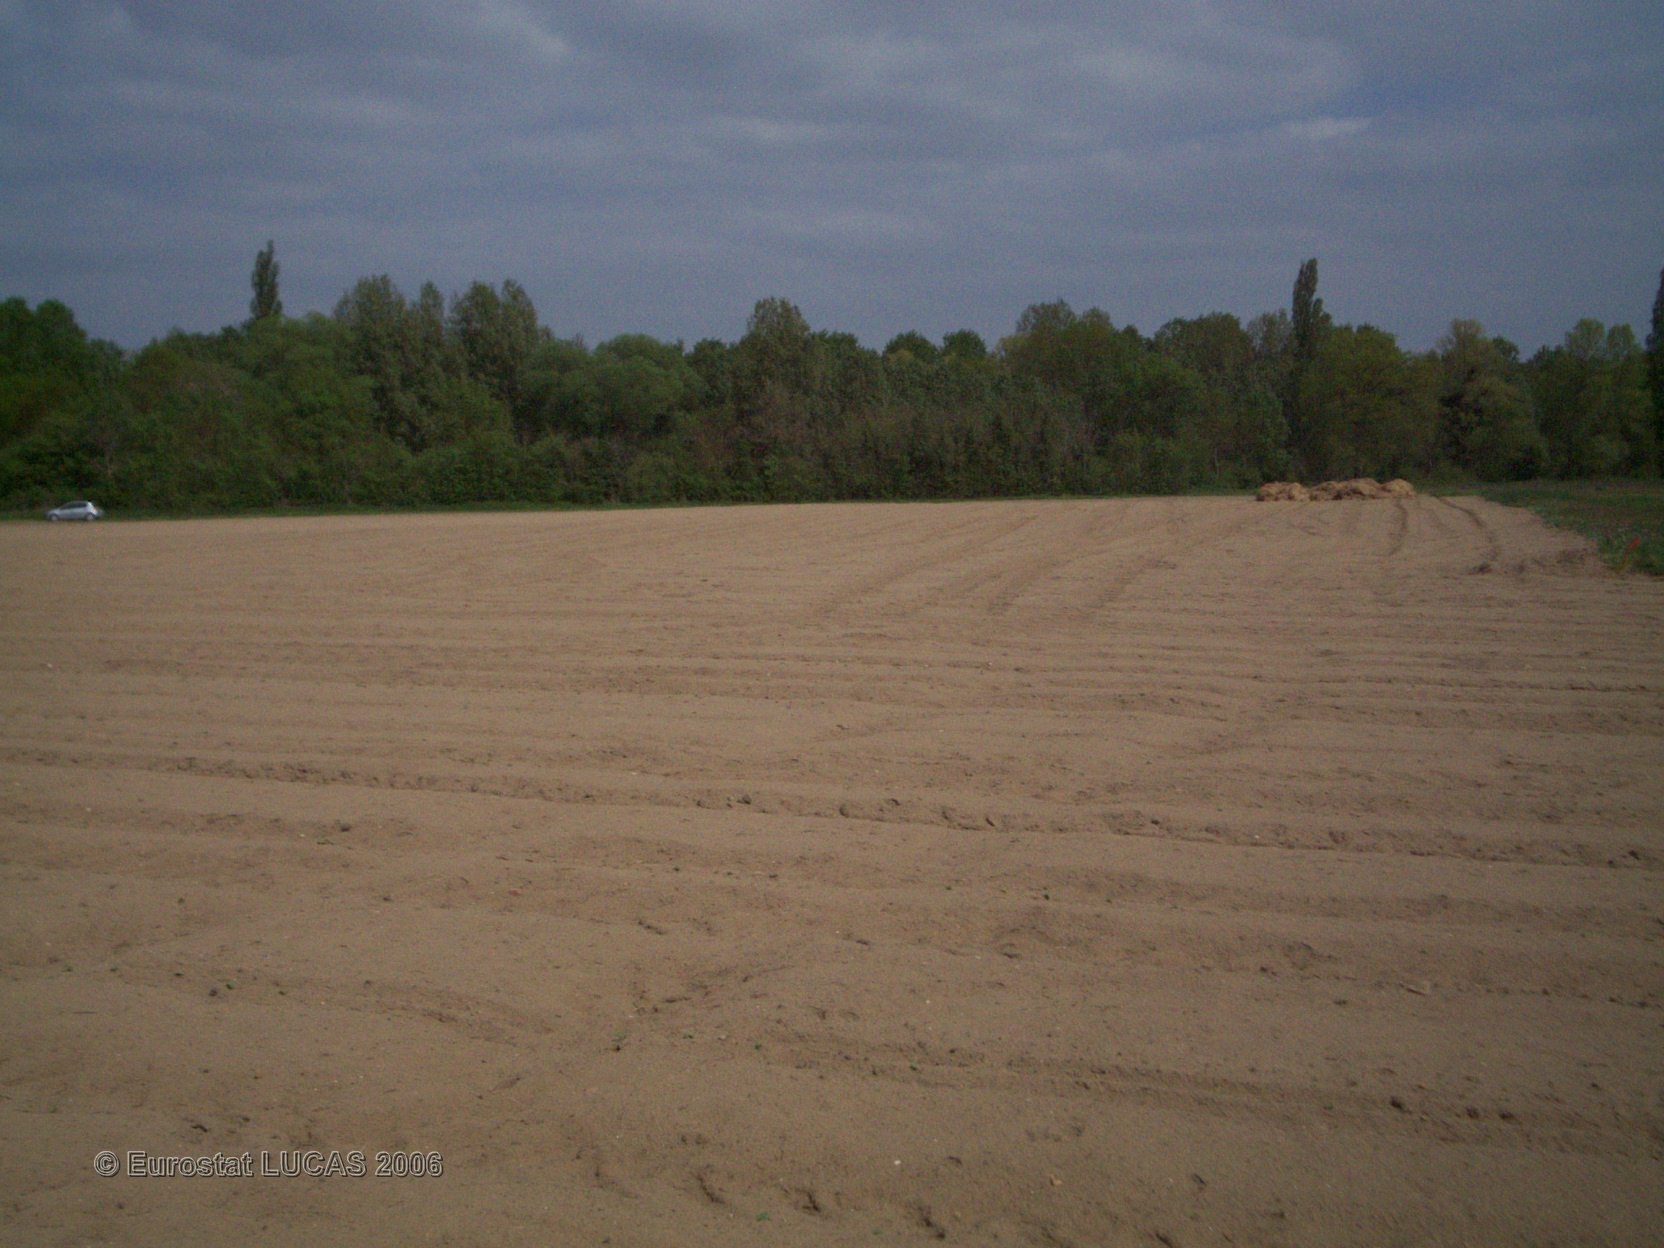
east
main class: Cropland
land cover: Sunflower
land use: Agriculture (excluding fallow land and kitchen gardens)
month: April
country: FR
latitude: 47.1411
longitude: 0.2865
